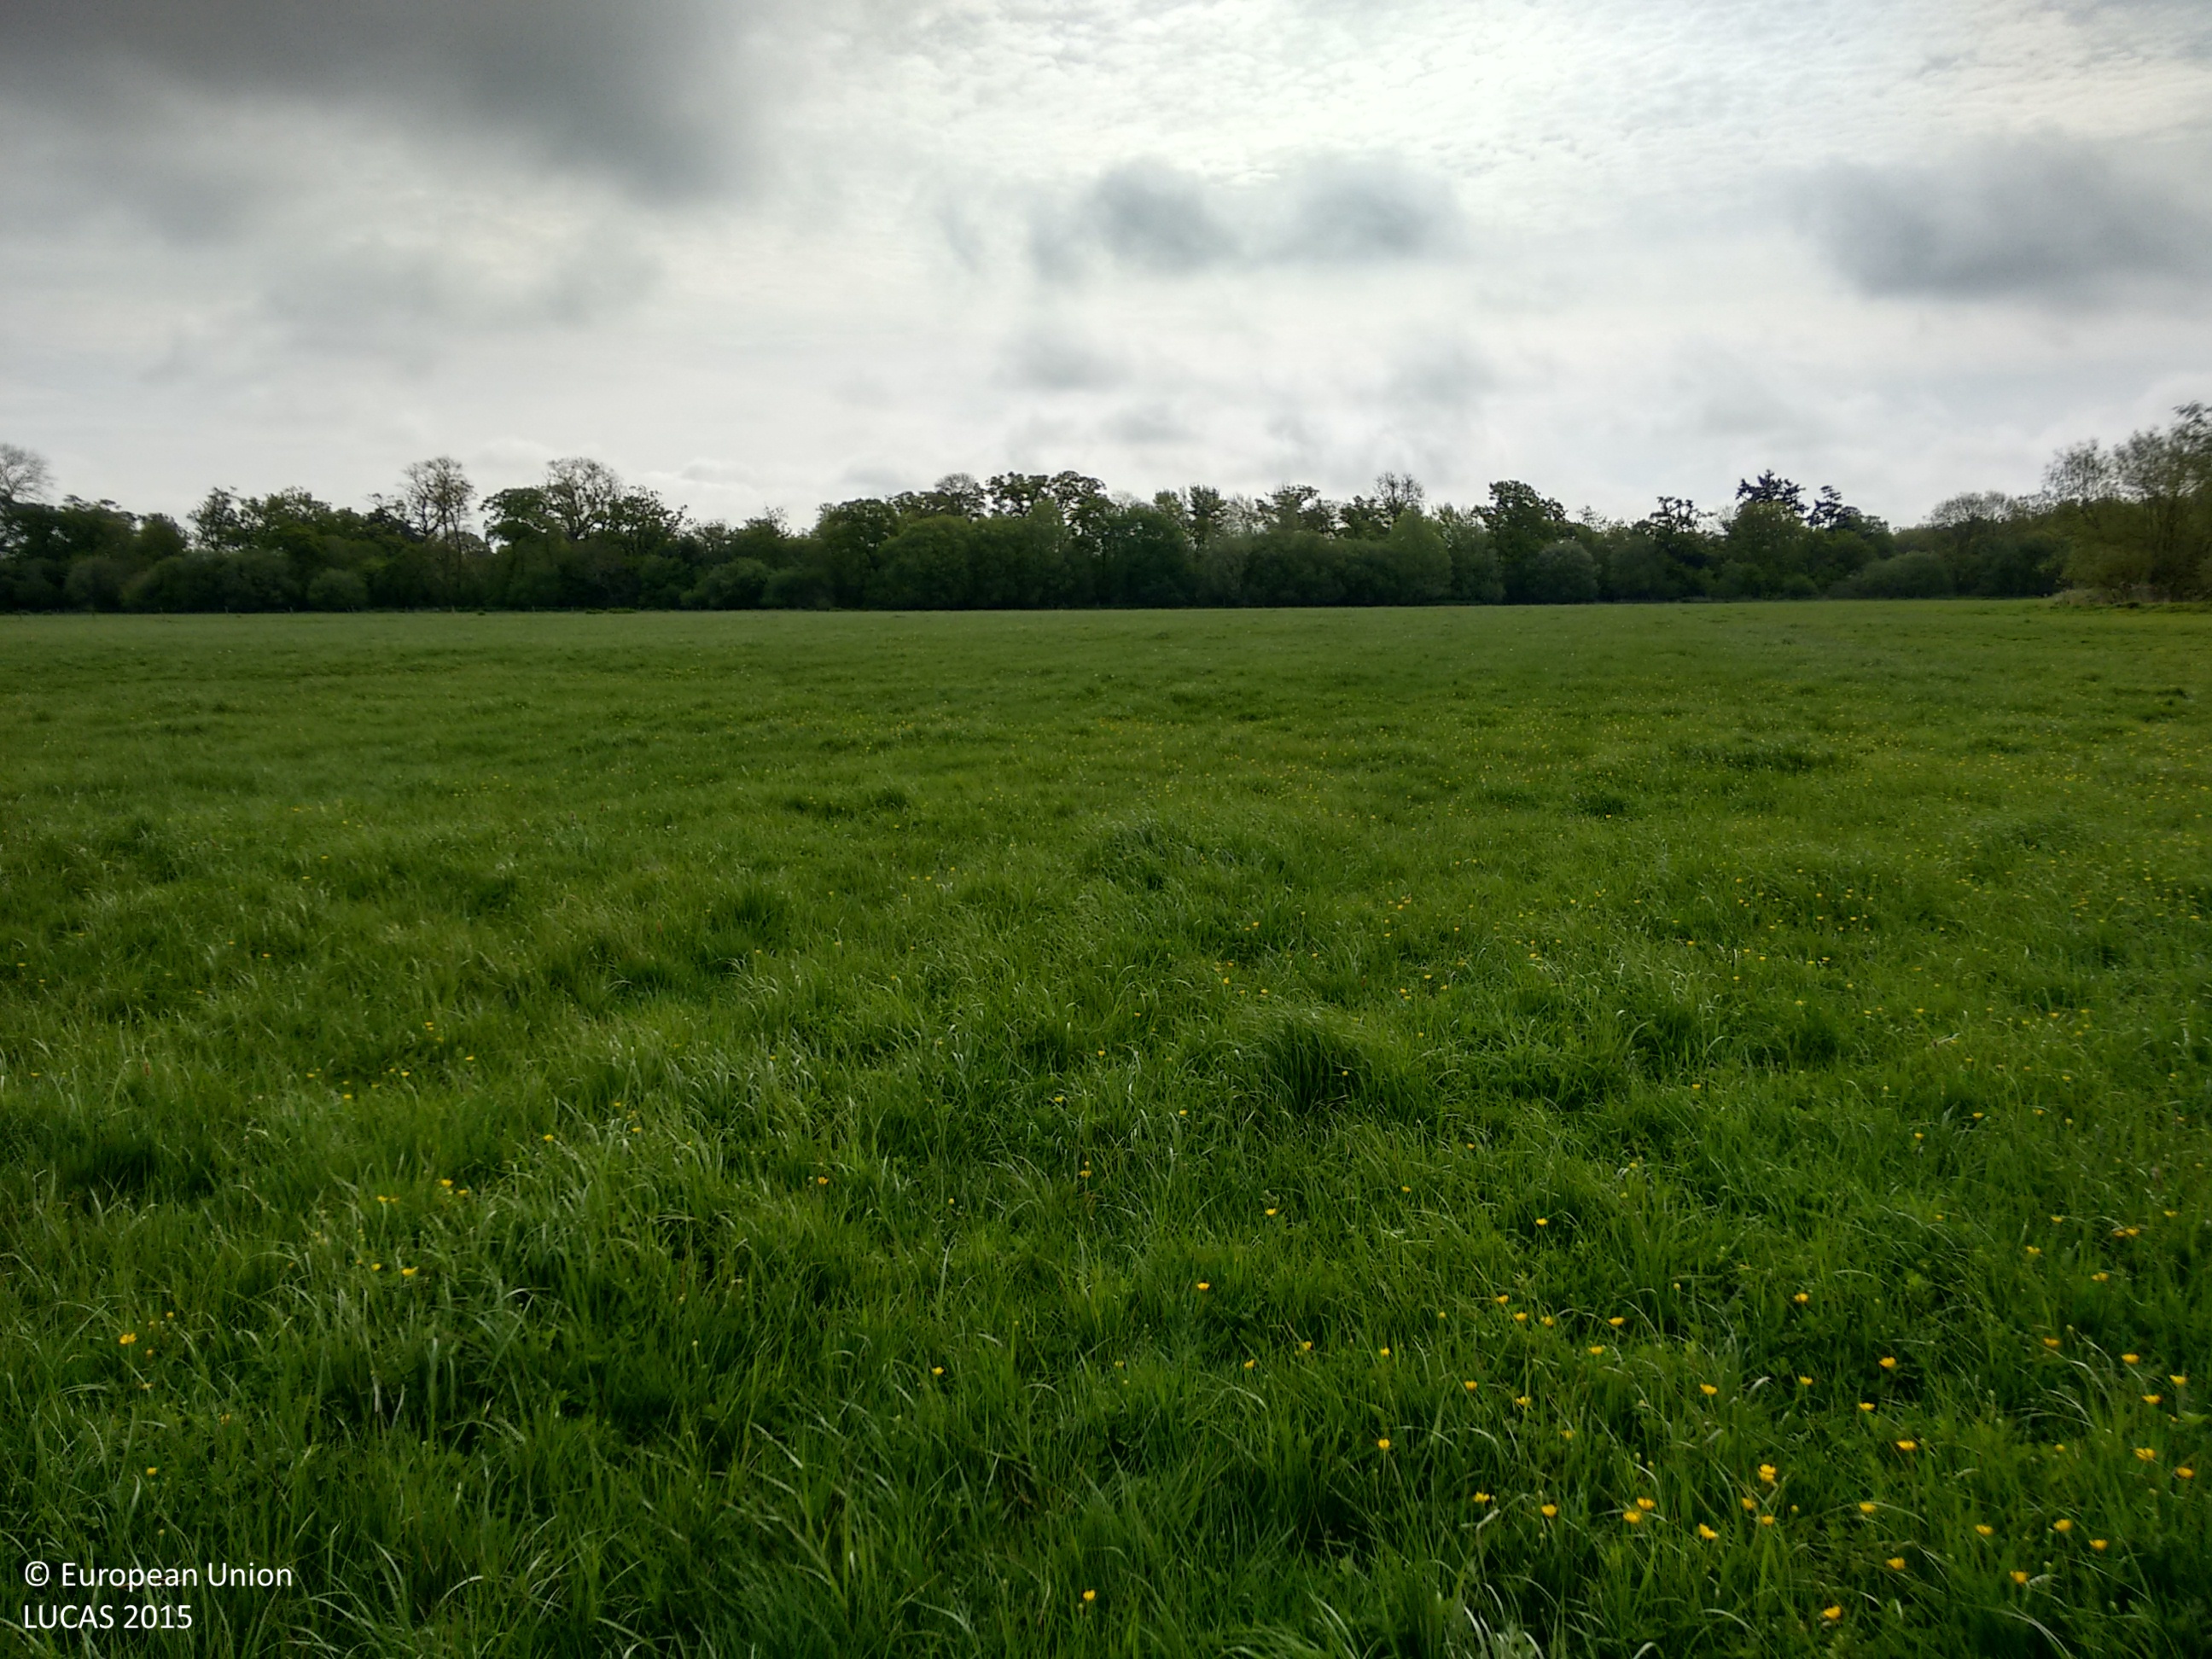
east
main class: Grassland
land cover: Grassland without tree/shrub cover
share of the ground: > 75 %
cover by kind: herbaceous plants 100 %
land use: Agriculture (excluding fallow land and kitchen gardens)
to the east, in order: Grassland without tree/shrub cover
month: May
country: GB
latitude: 50.7647
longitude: -1.8376
